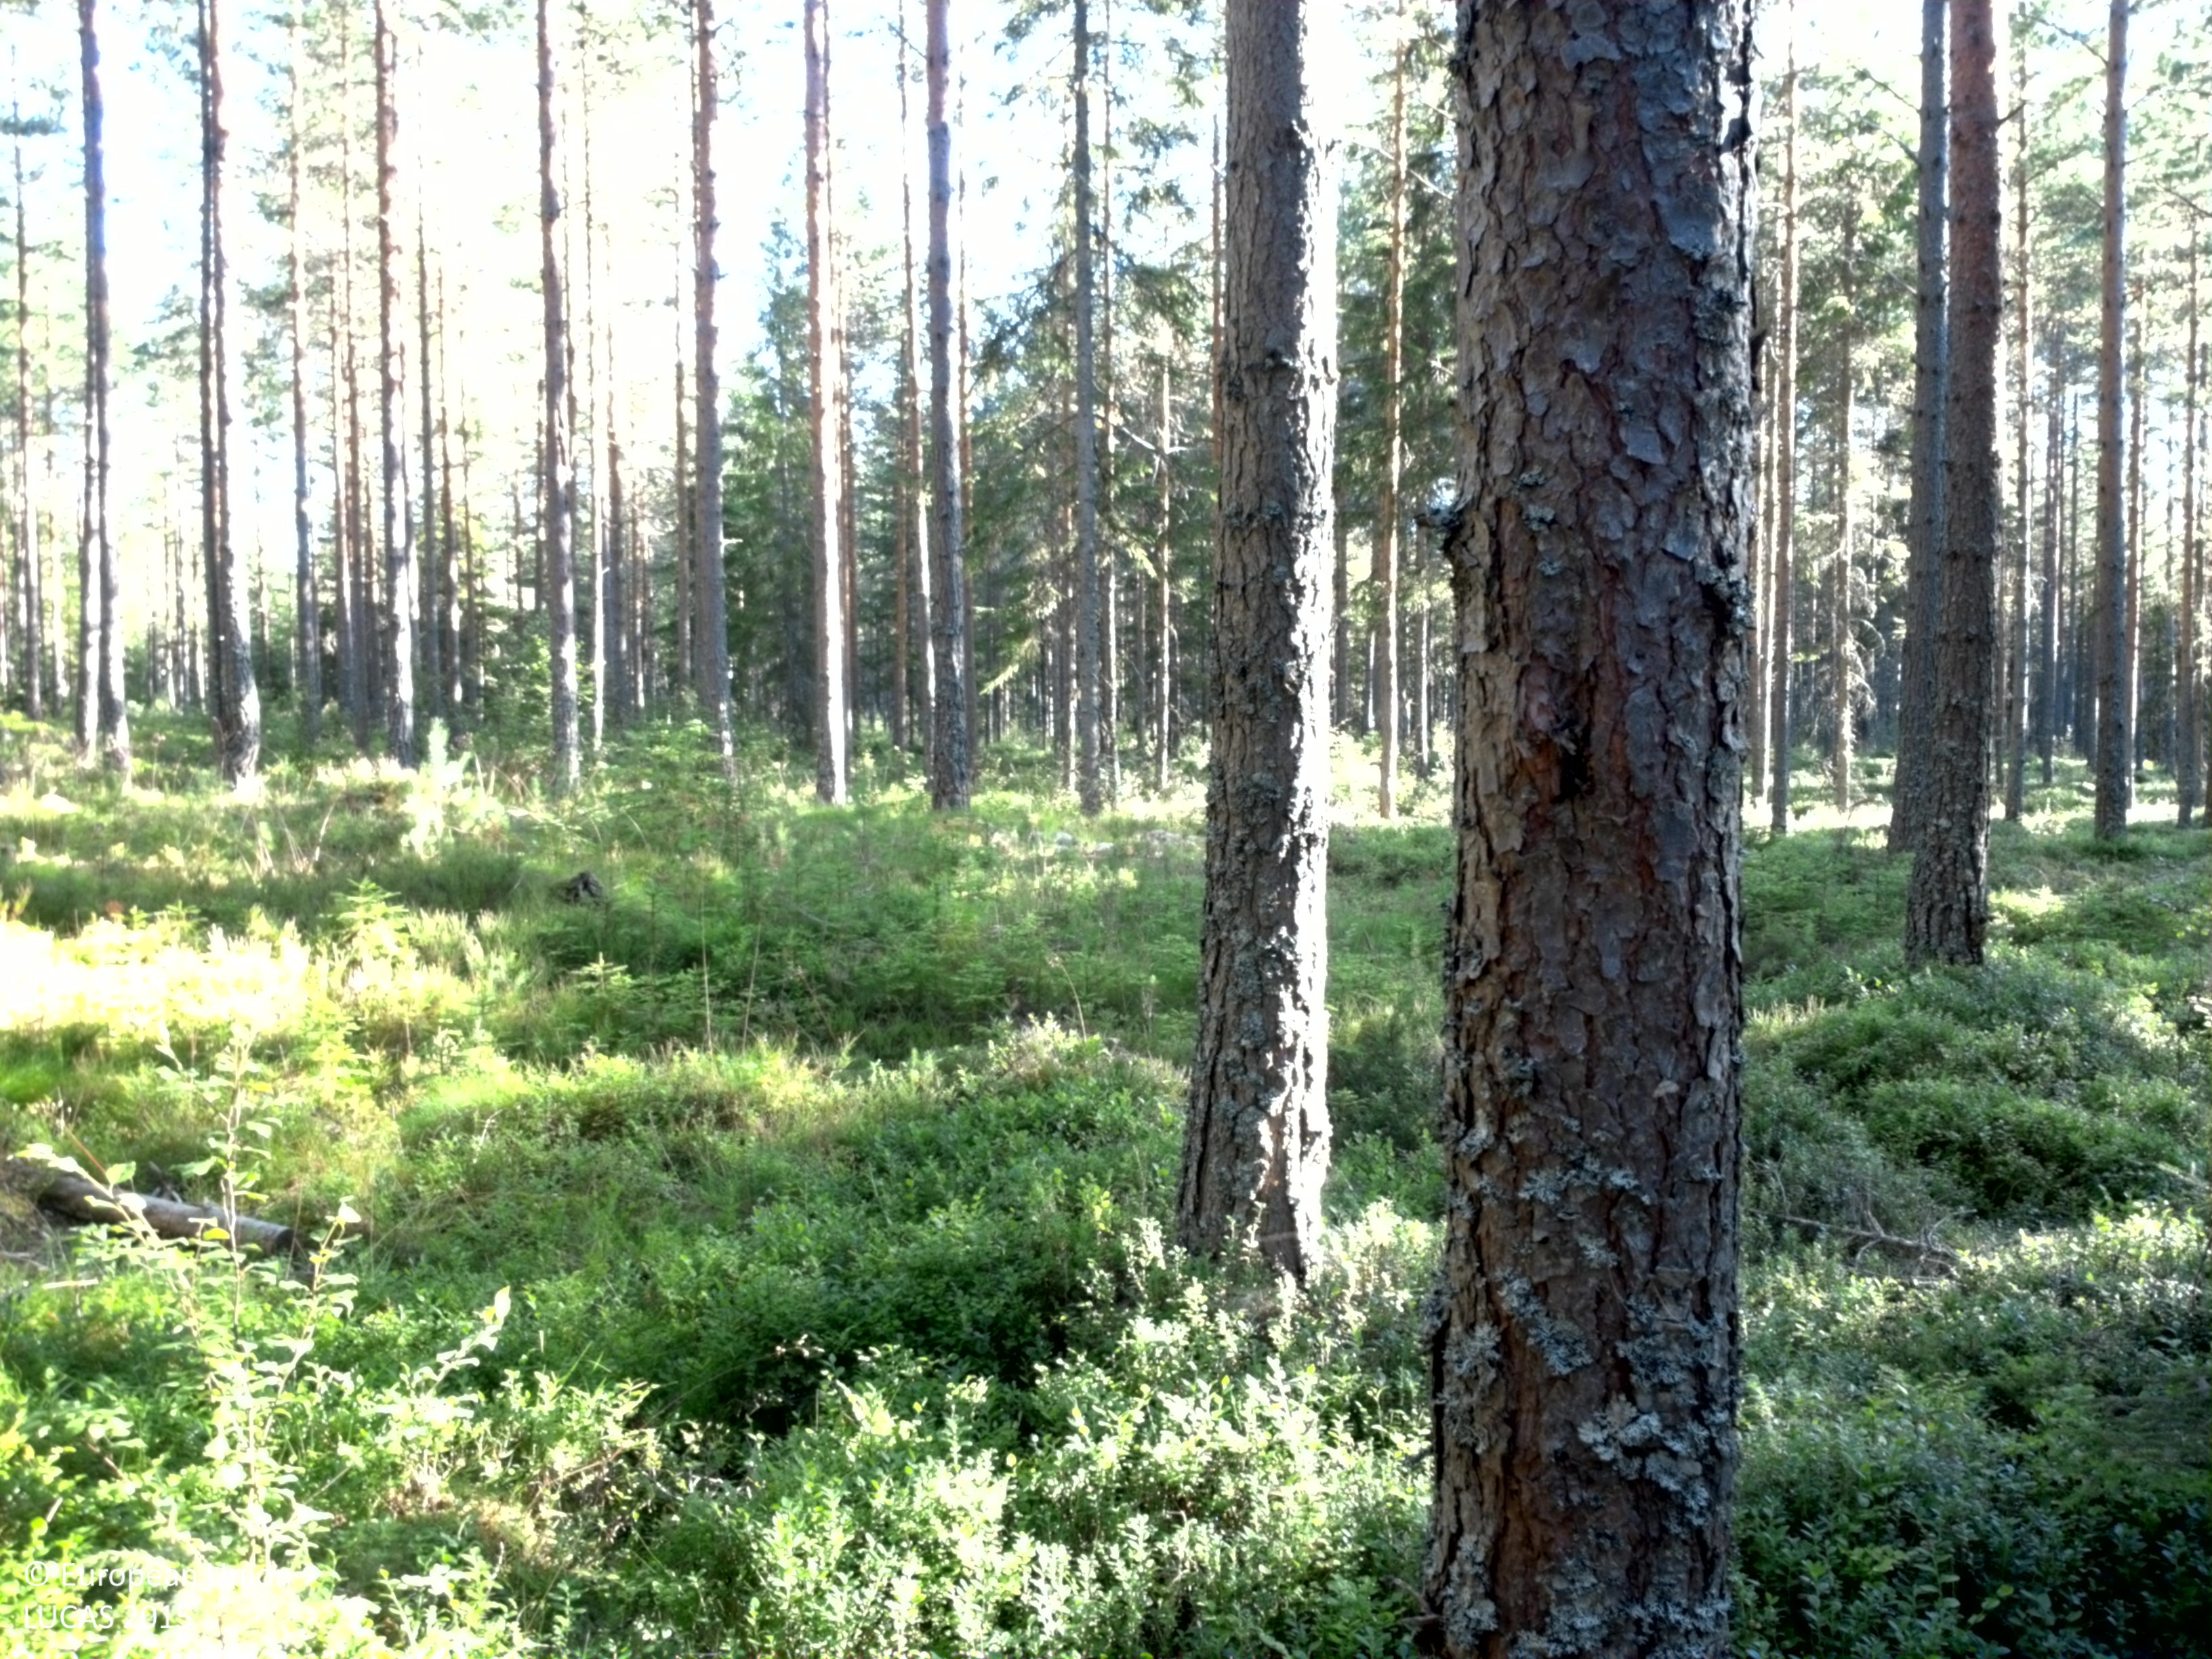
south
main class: Woodland
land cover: Pine dominated coniferous woodland
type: boreal forest
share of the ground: 50 - 75 %
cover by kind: coniferous forest trees 70 %, shrubs 25 %, lichens and mosses 5 %
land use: Forestry
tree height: > 5 m
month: August
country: SE
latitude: 60.1902
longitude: 13.5430
